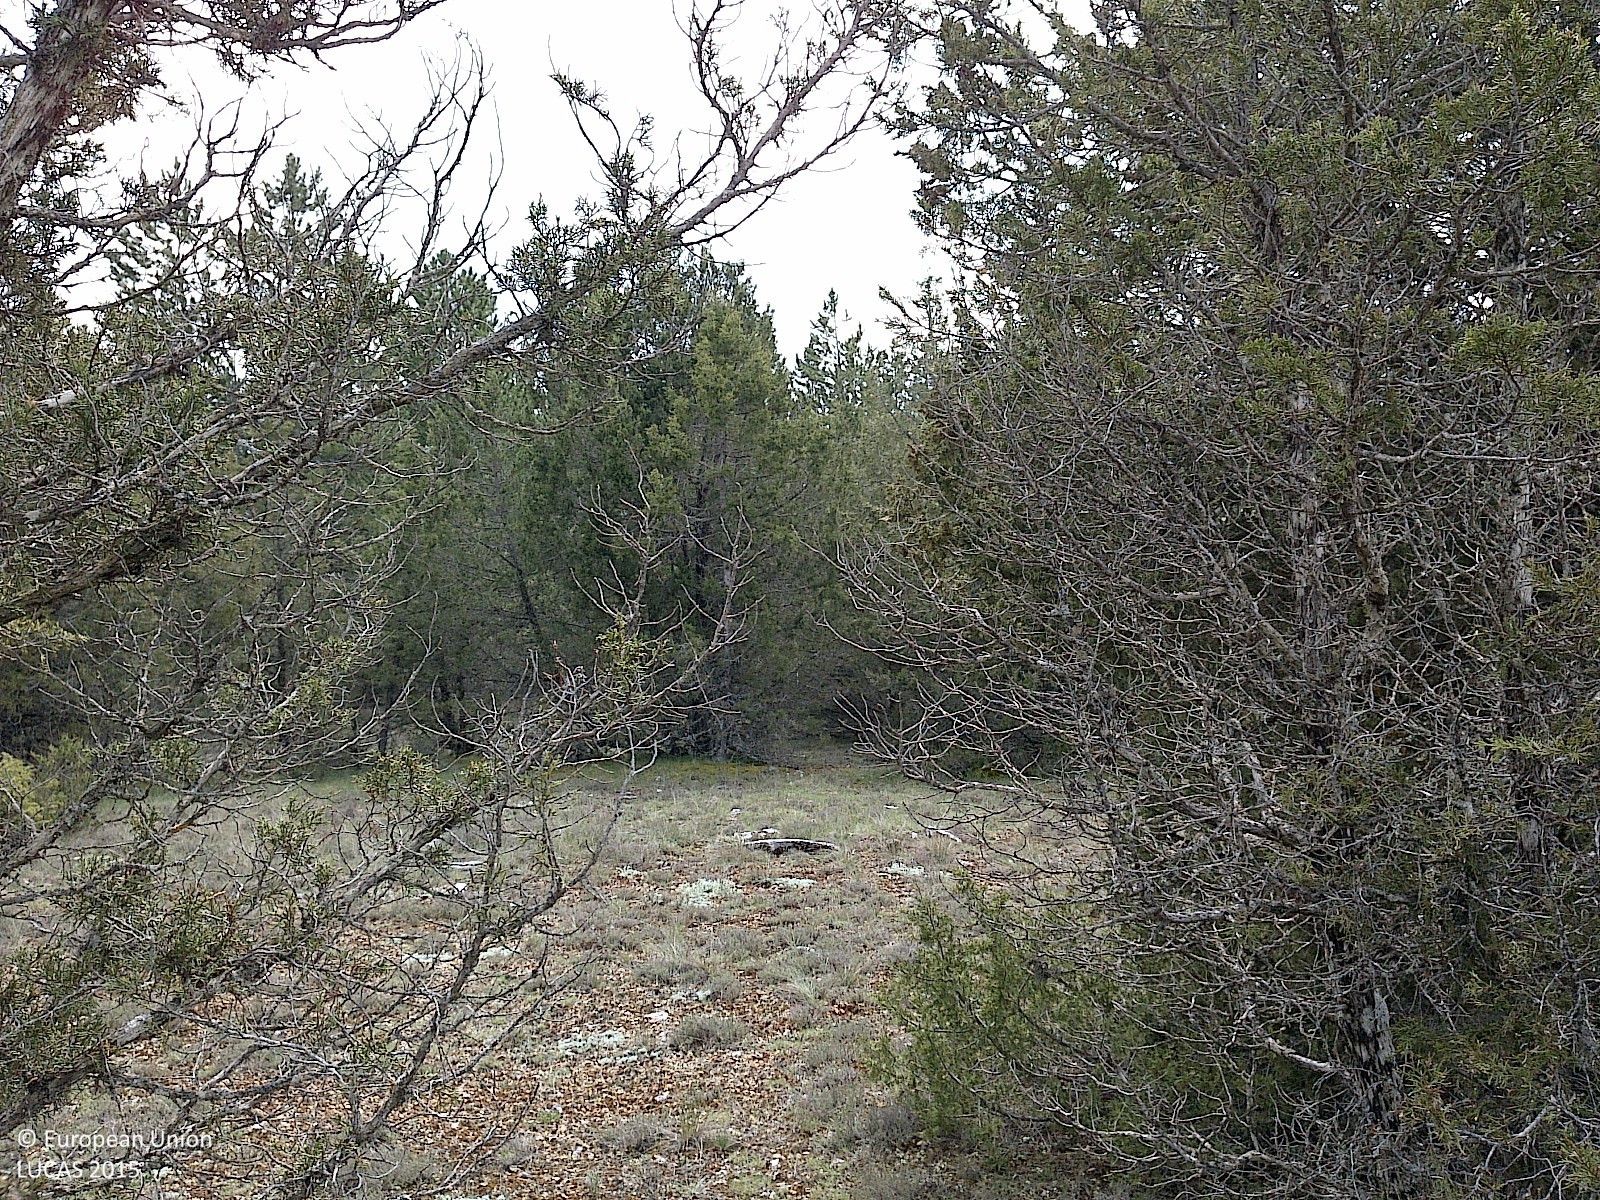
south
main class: Woodland
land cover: Other coniferous woodland
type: coniferous forest of the mediterranean region
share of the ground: 25 - 50 %
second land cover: Grassland without tree/shrub cover
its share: > 75 %
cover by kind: herbaceous plants 65 %, coniferous forest trees 35 %
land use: Forestry
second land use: Agriculture (excluding fallow land and kitchen gardens)
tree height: < 5 m
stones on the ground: 10 - 25 %
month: April
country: ES
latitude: 41.7646
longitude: -2.8043
